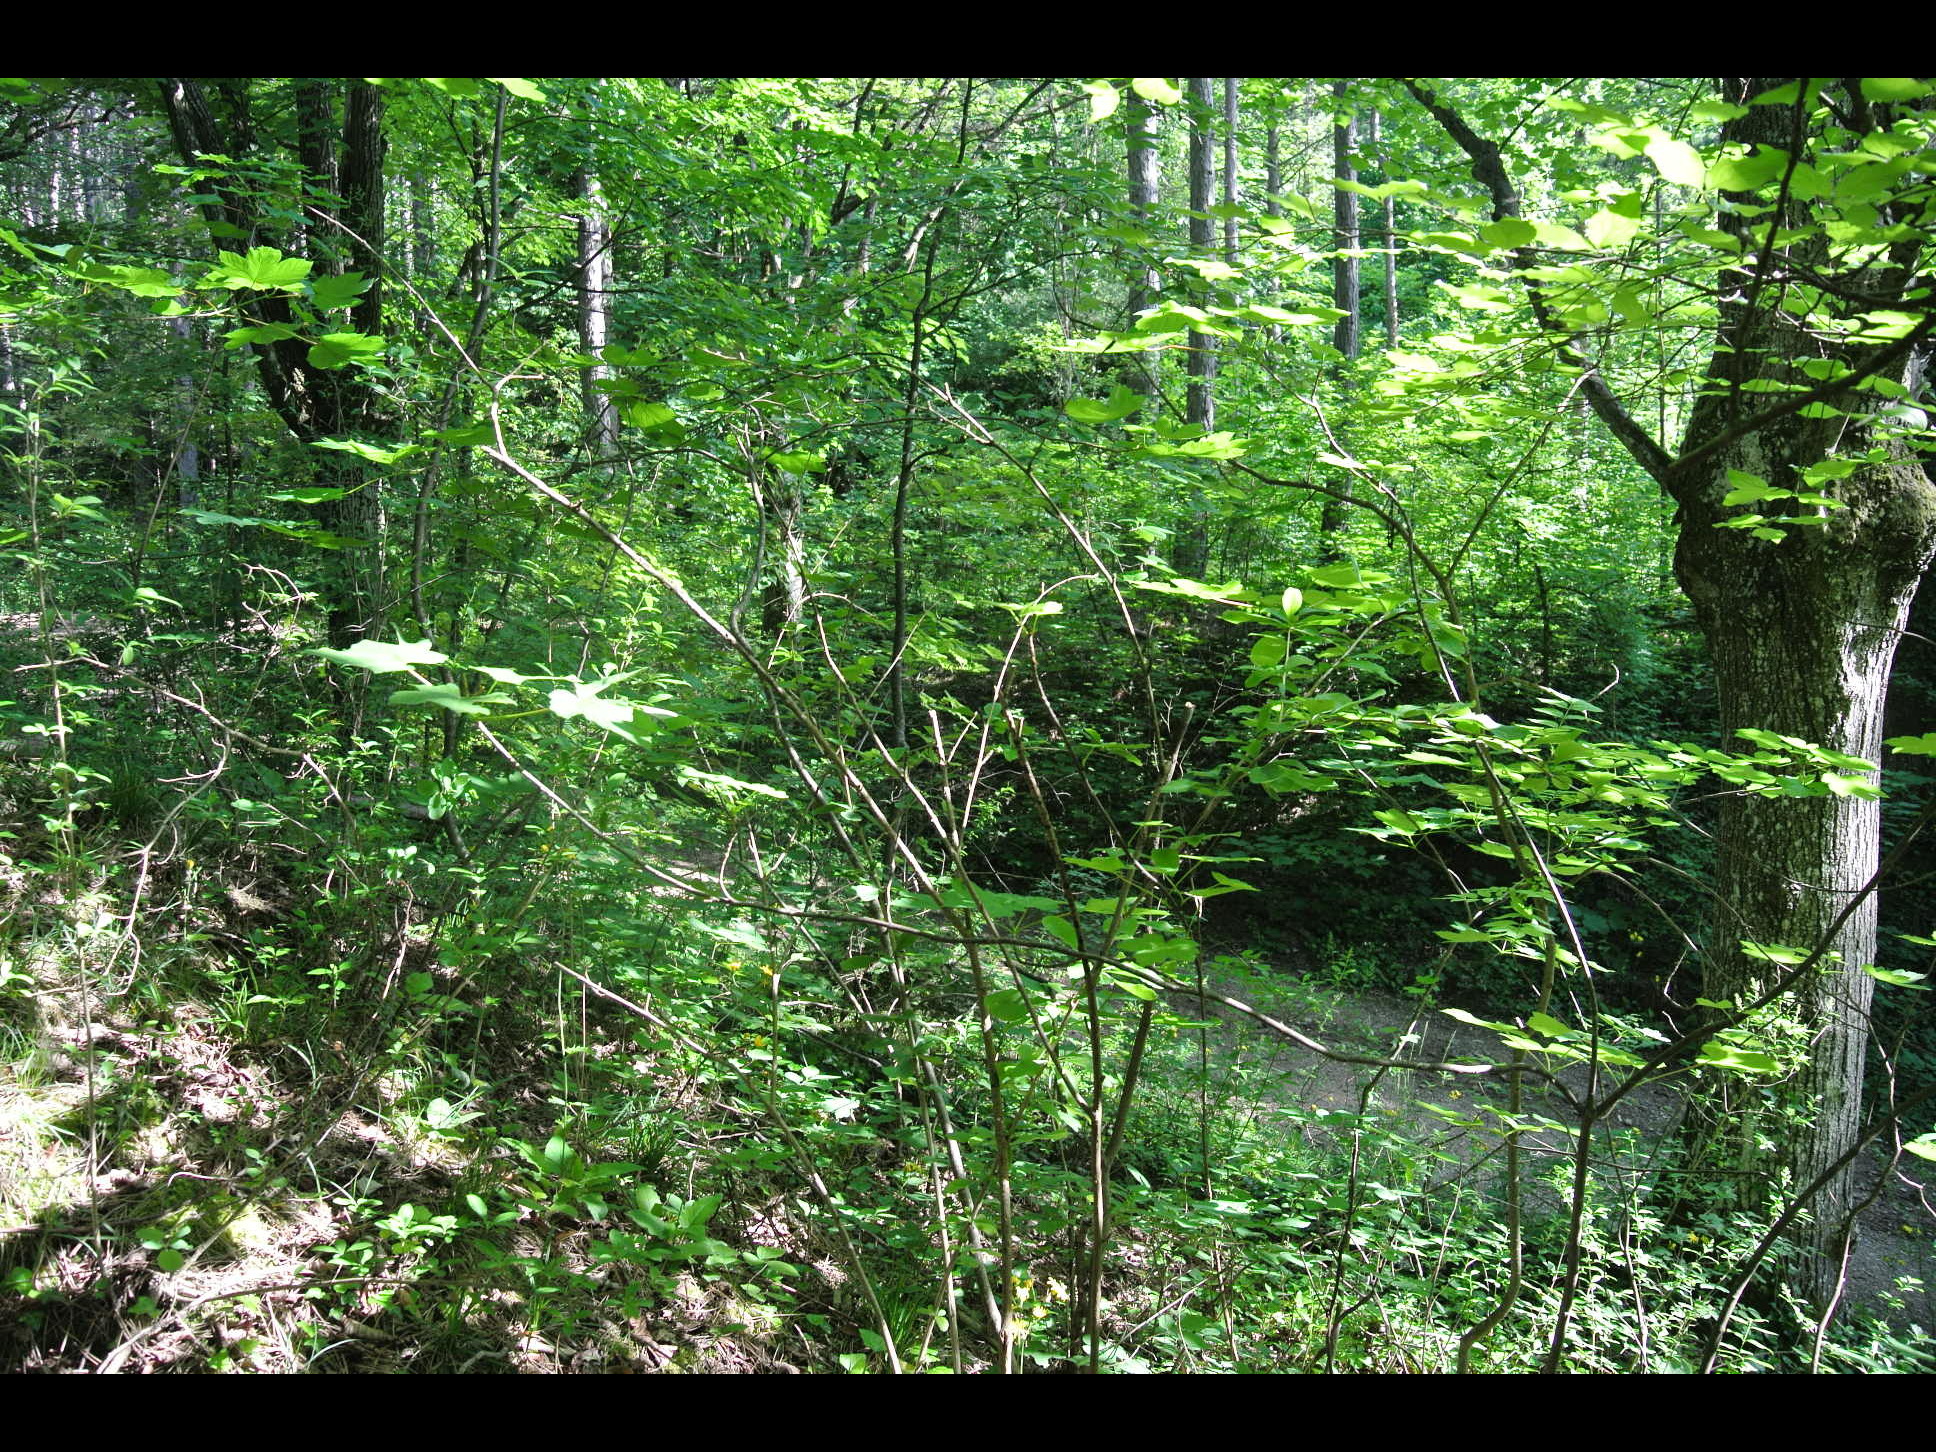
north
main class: Woodland
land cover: Pine dominated mixed woodland
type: alpine coniferous forest
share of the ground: > 75 %
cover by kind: broadleaved forest trees 75 %, coniferous forest trees 25 %
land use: Forestry
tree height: > 5 m
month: May
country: AT
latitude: 47.8346
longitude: 16.1625
